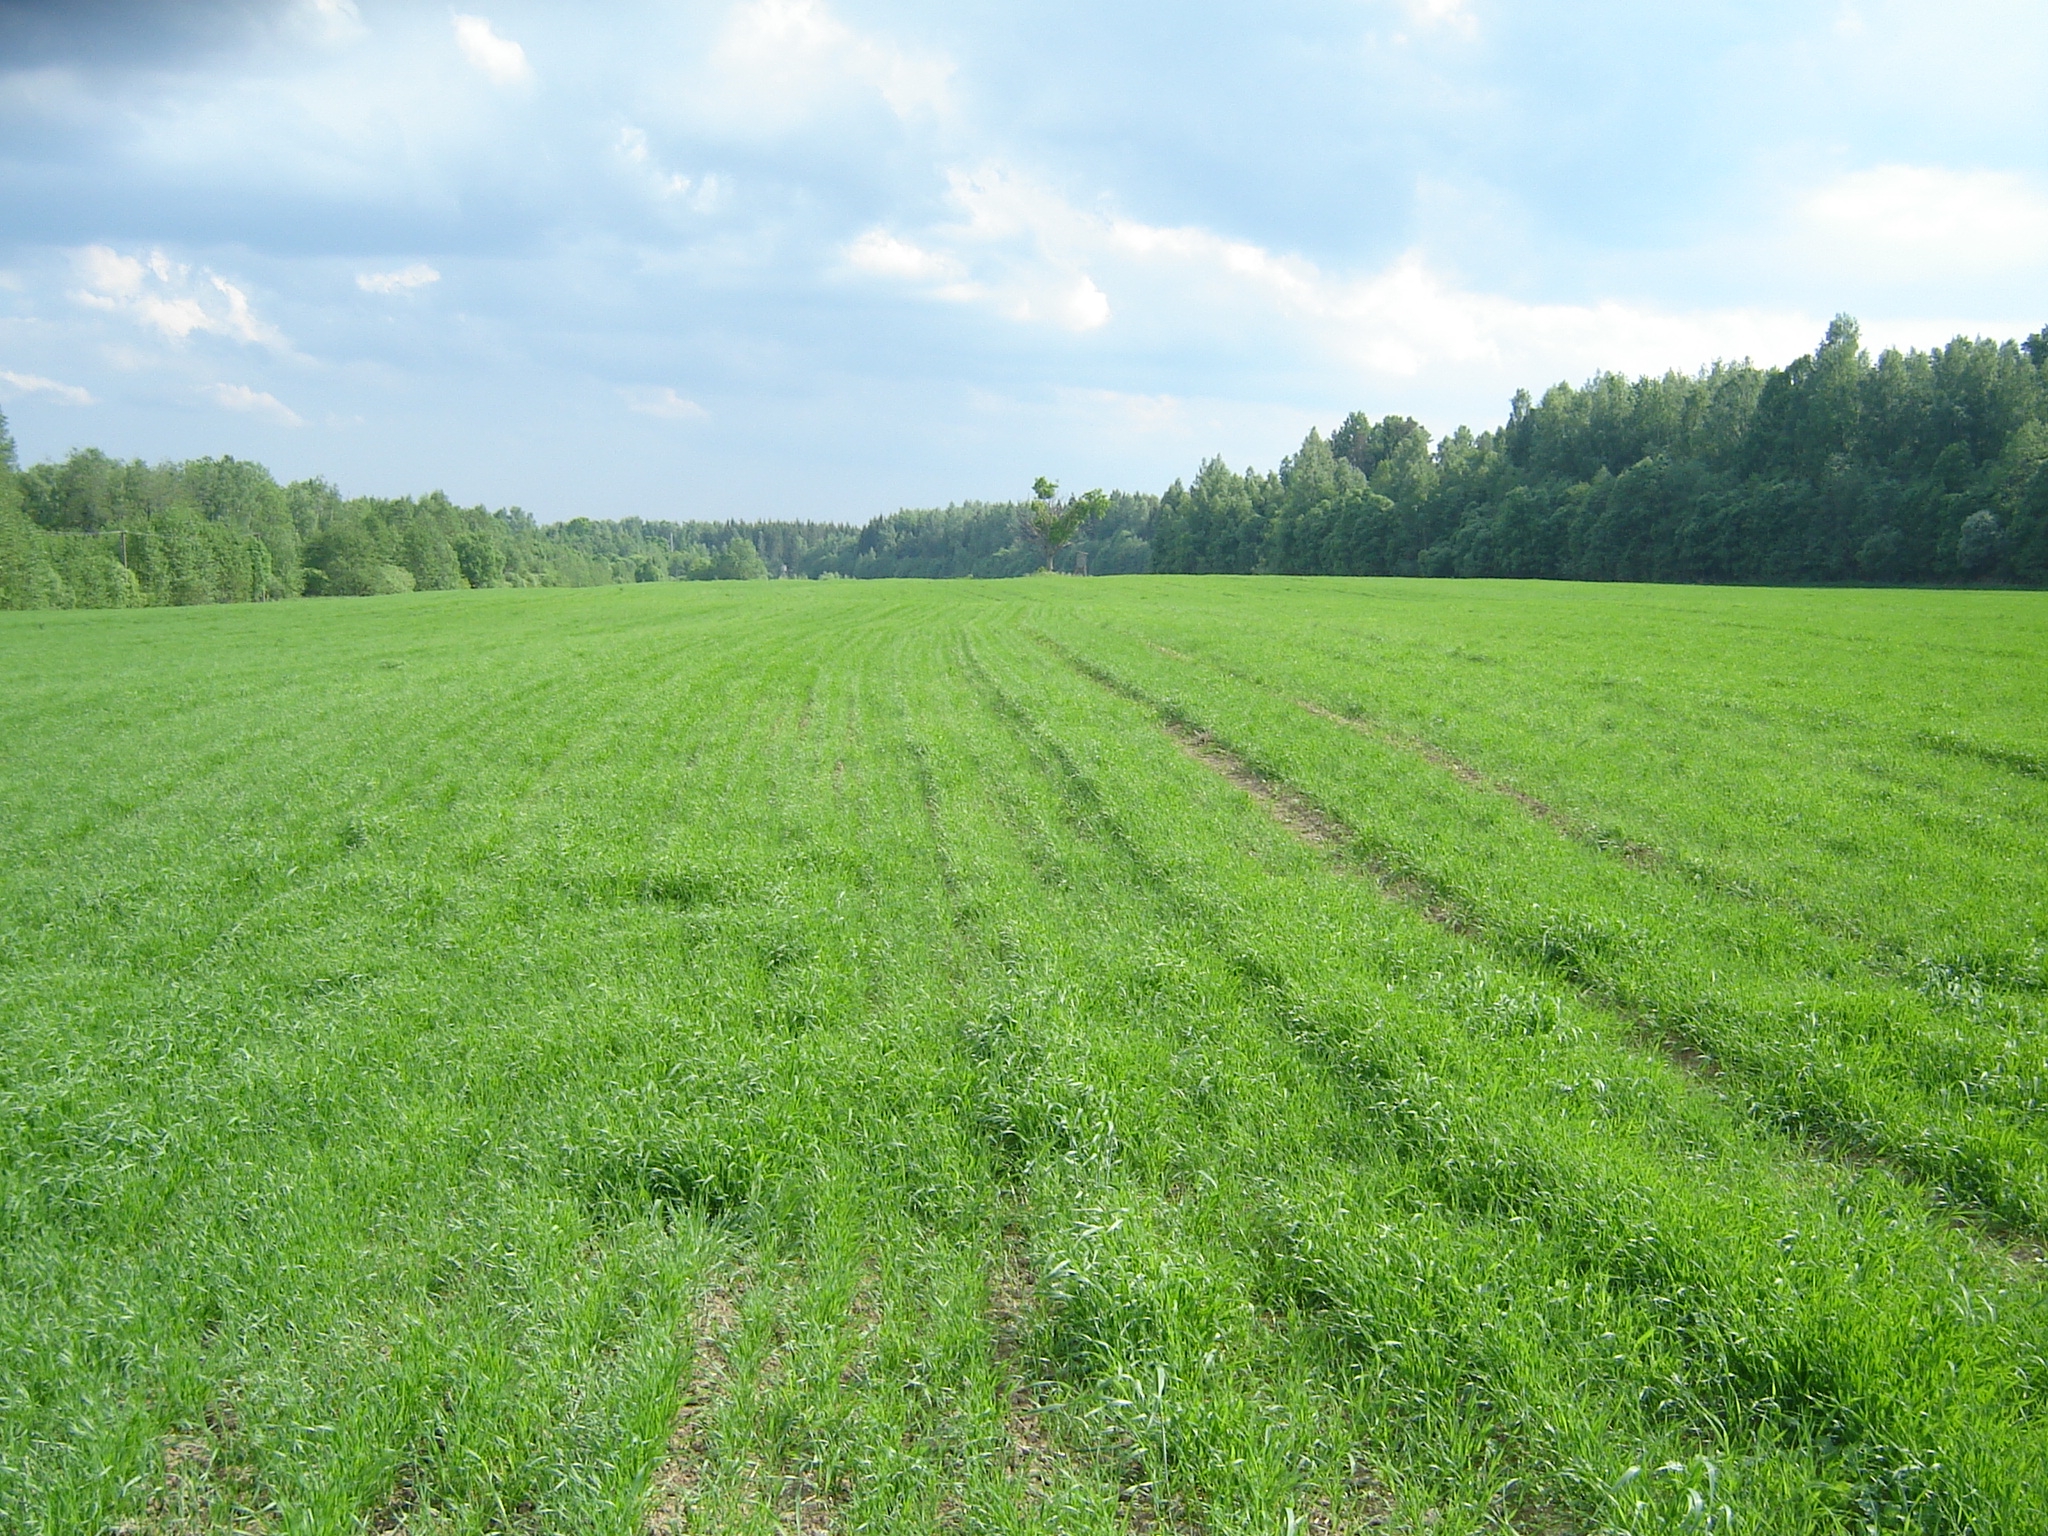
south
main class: Cropland
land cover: Common wheat
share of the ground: > 75 %
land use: Agriculture (excluding fallow land and kitchen gardens)
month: June
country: LT
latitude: 55.8870
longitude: 25.2902
